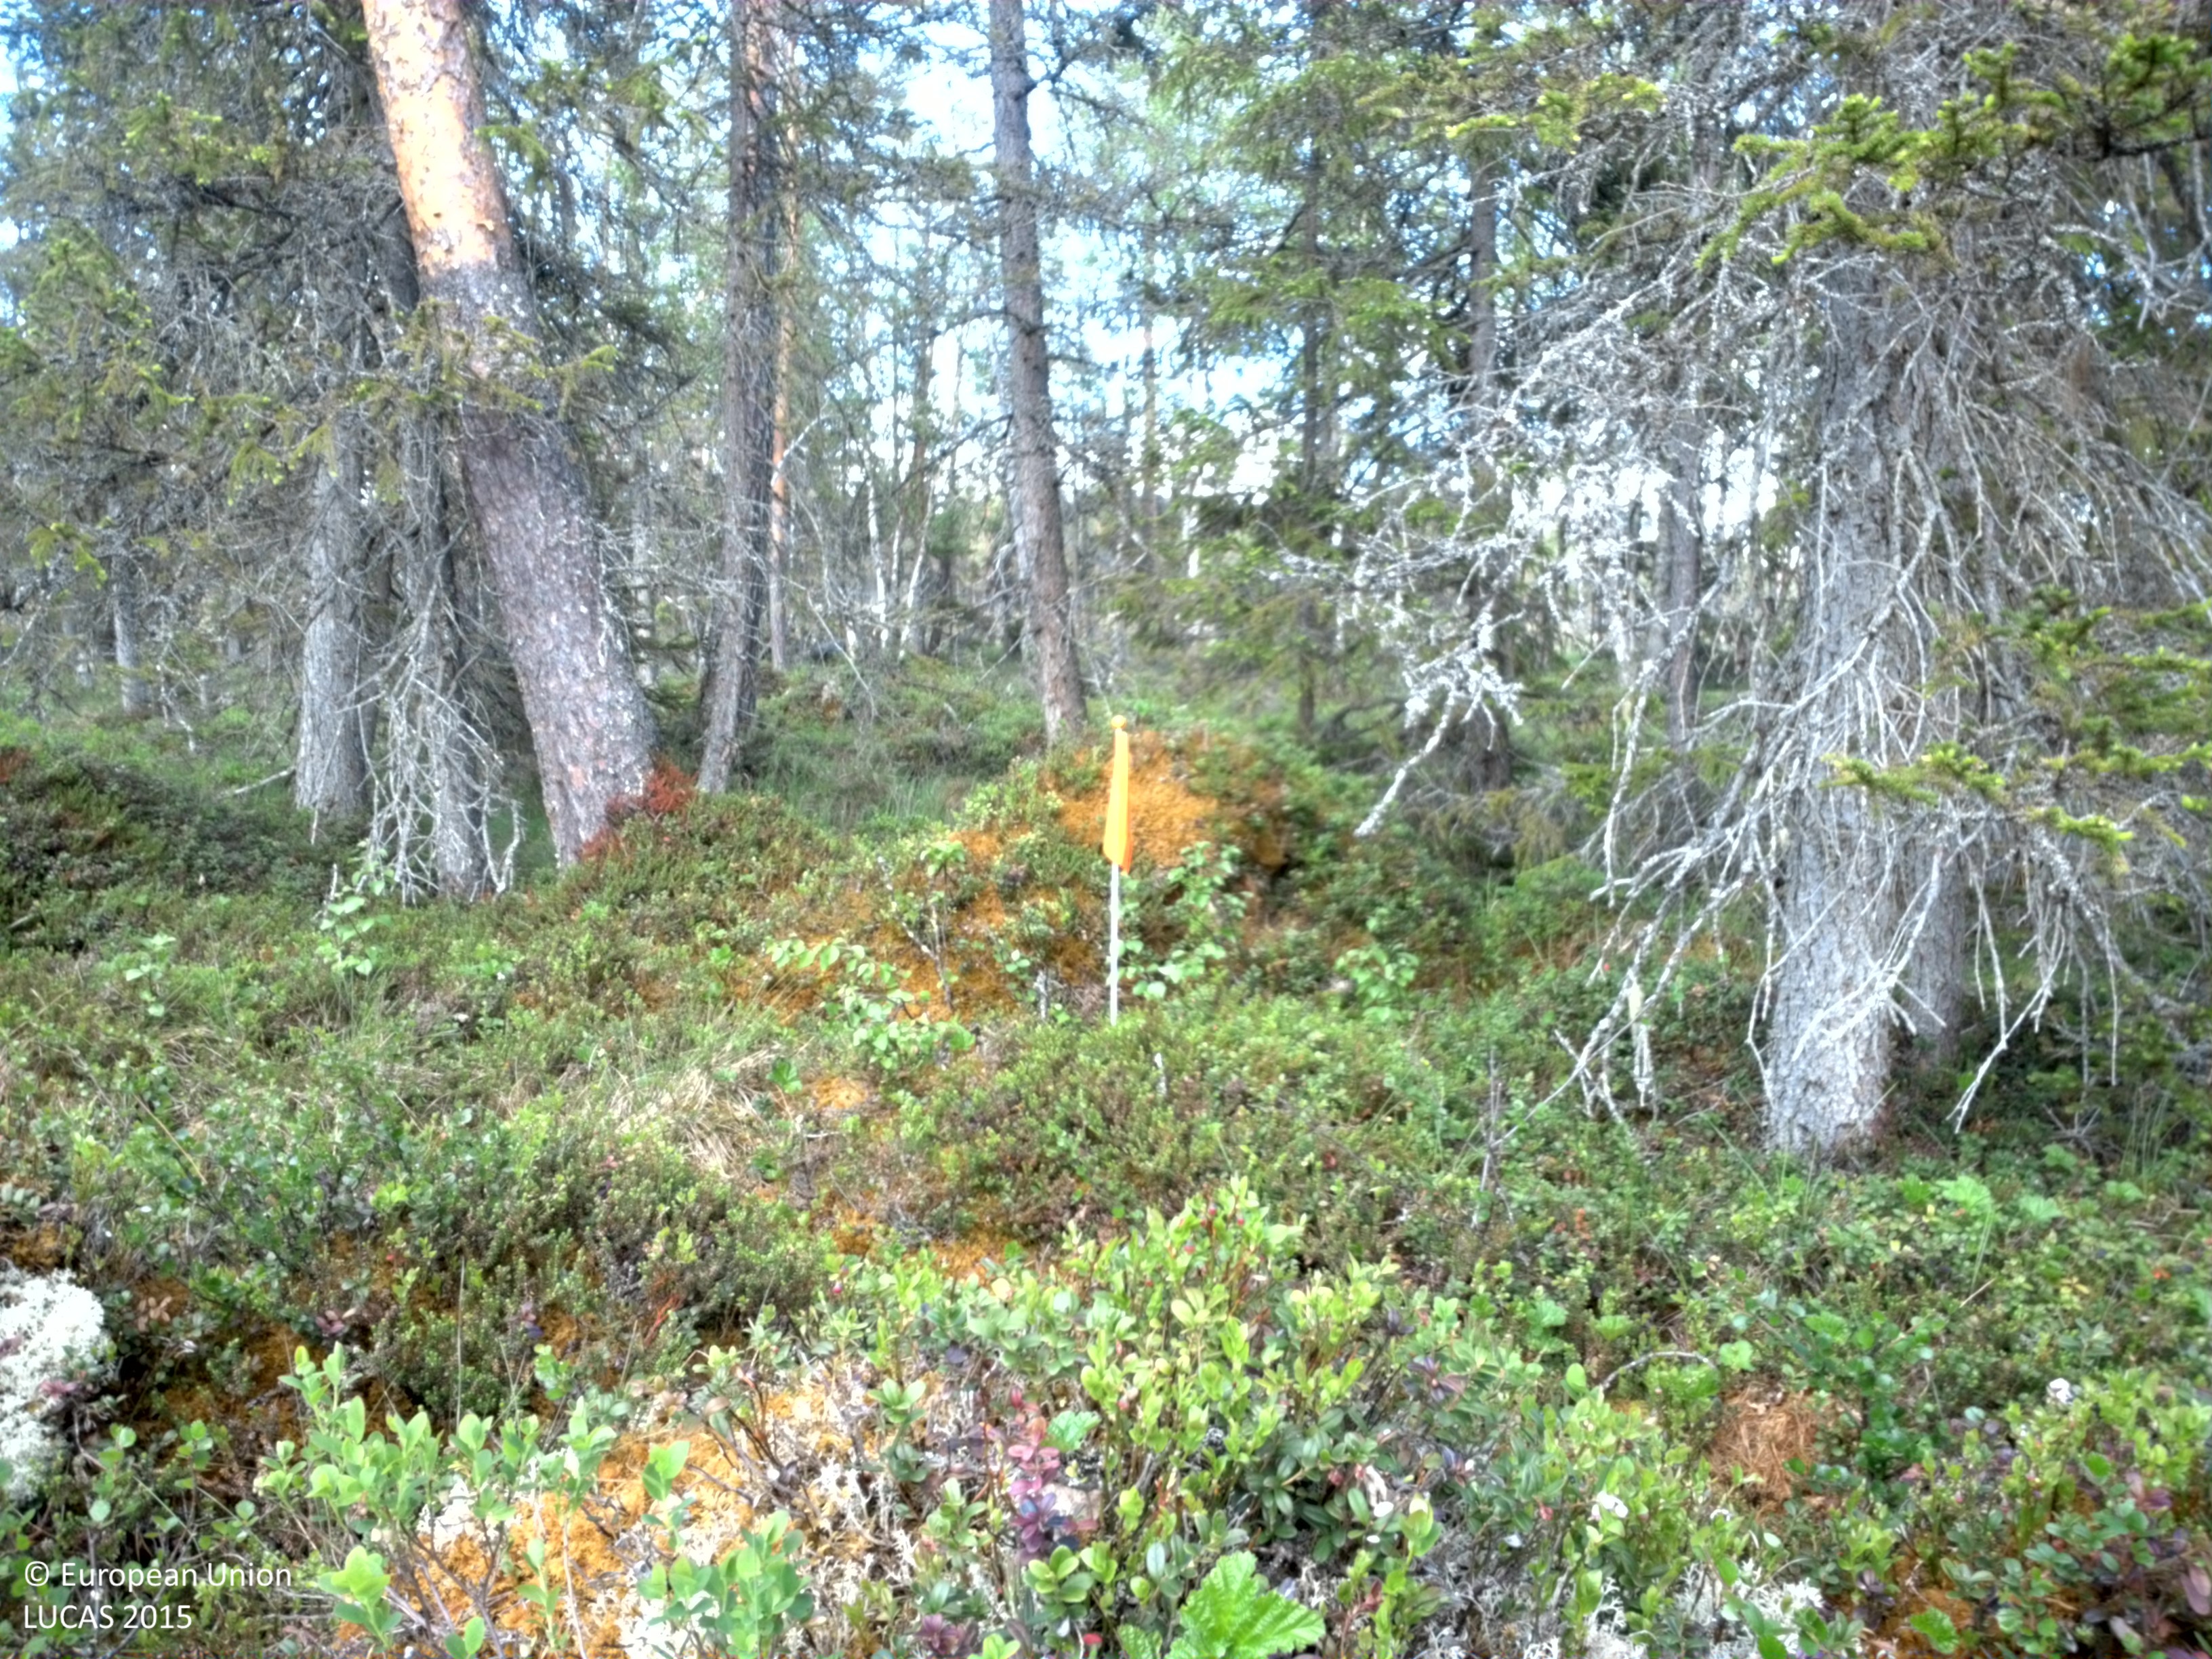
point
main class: Woodland
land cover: Other coniferous woodland
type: boreal forest
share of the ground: 25 - 50 %
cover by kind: shrubs 40 %, coniferous forest trees 25 %, lichens and mosses 20 %, herbaceous plants 15 %
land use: Forestry
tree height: > 5 m
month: June
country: SE
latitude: 61.8512
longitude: 12.5546
